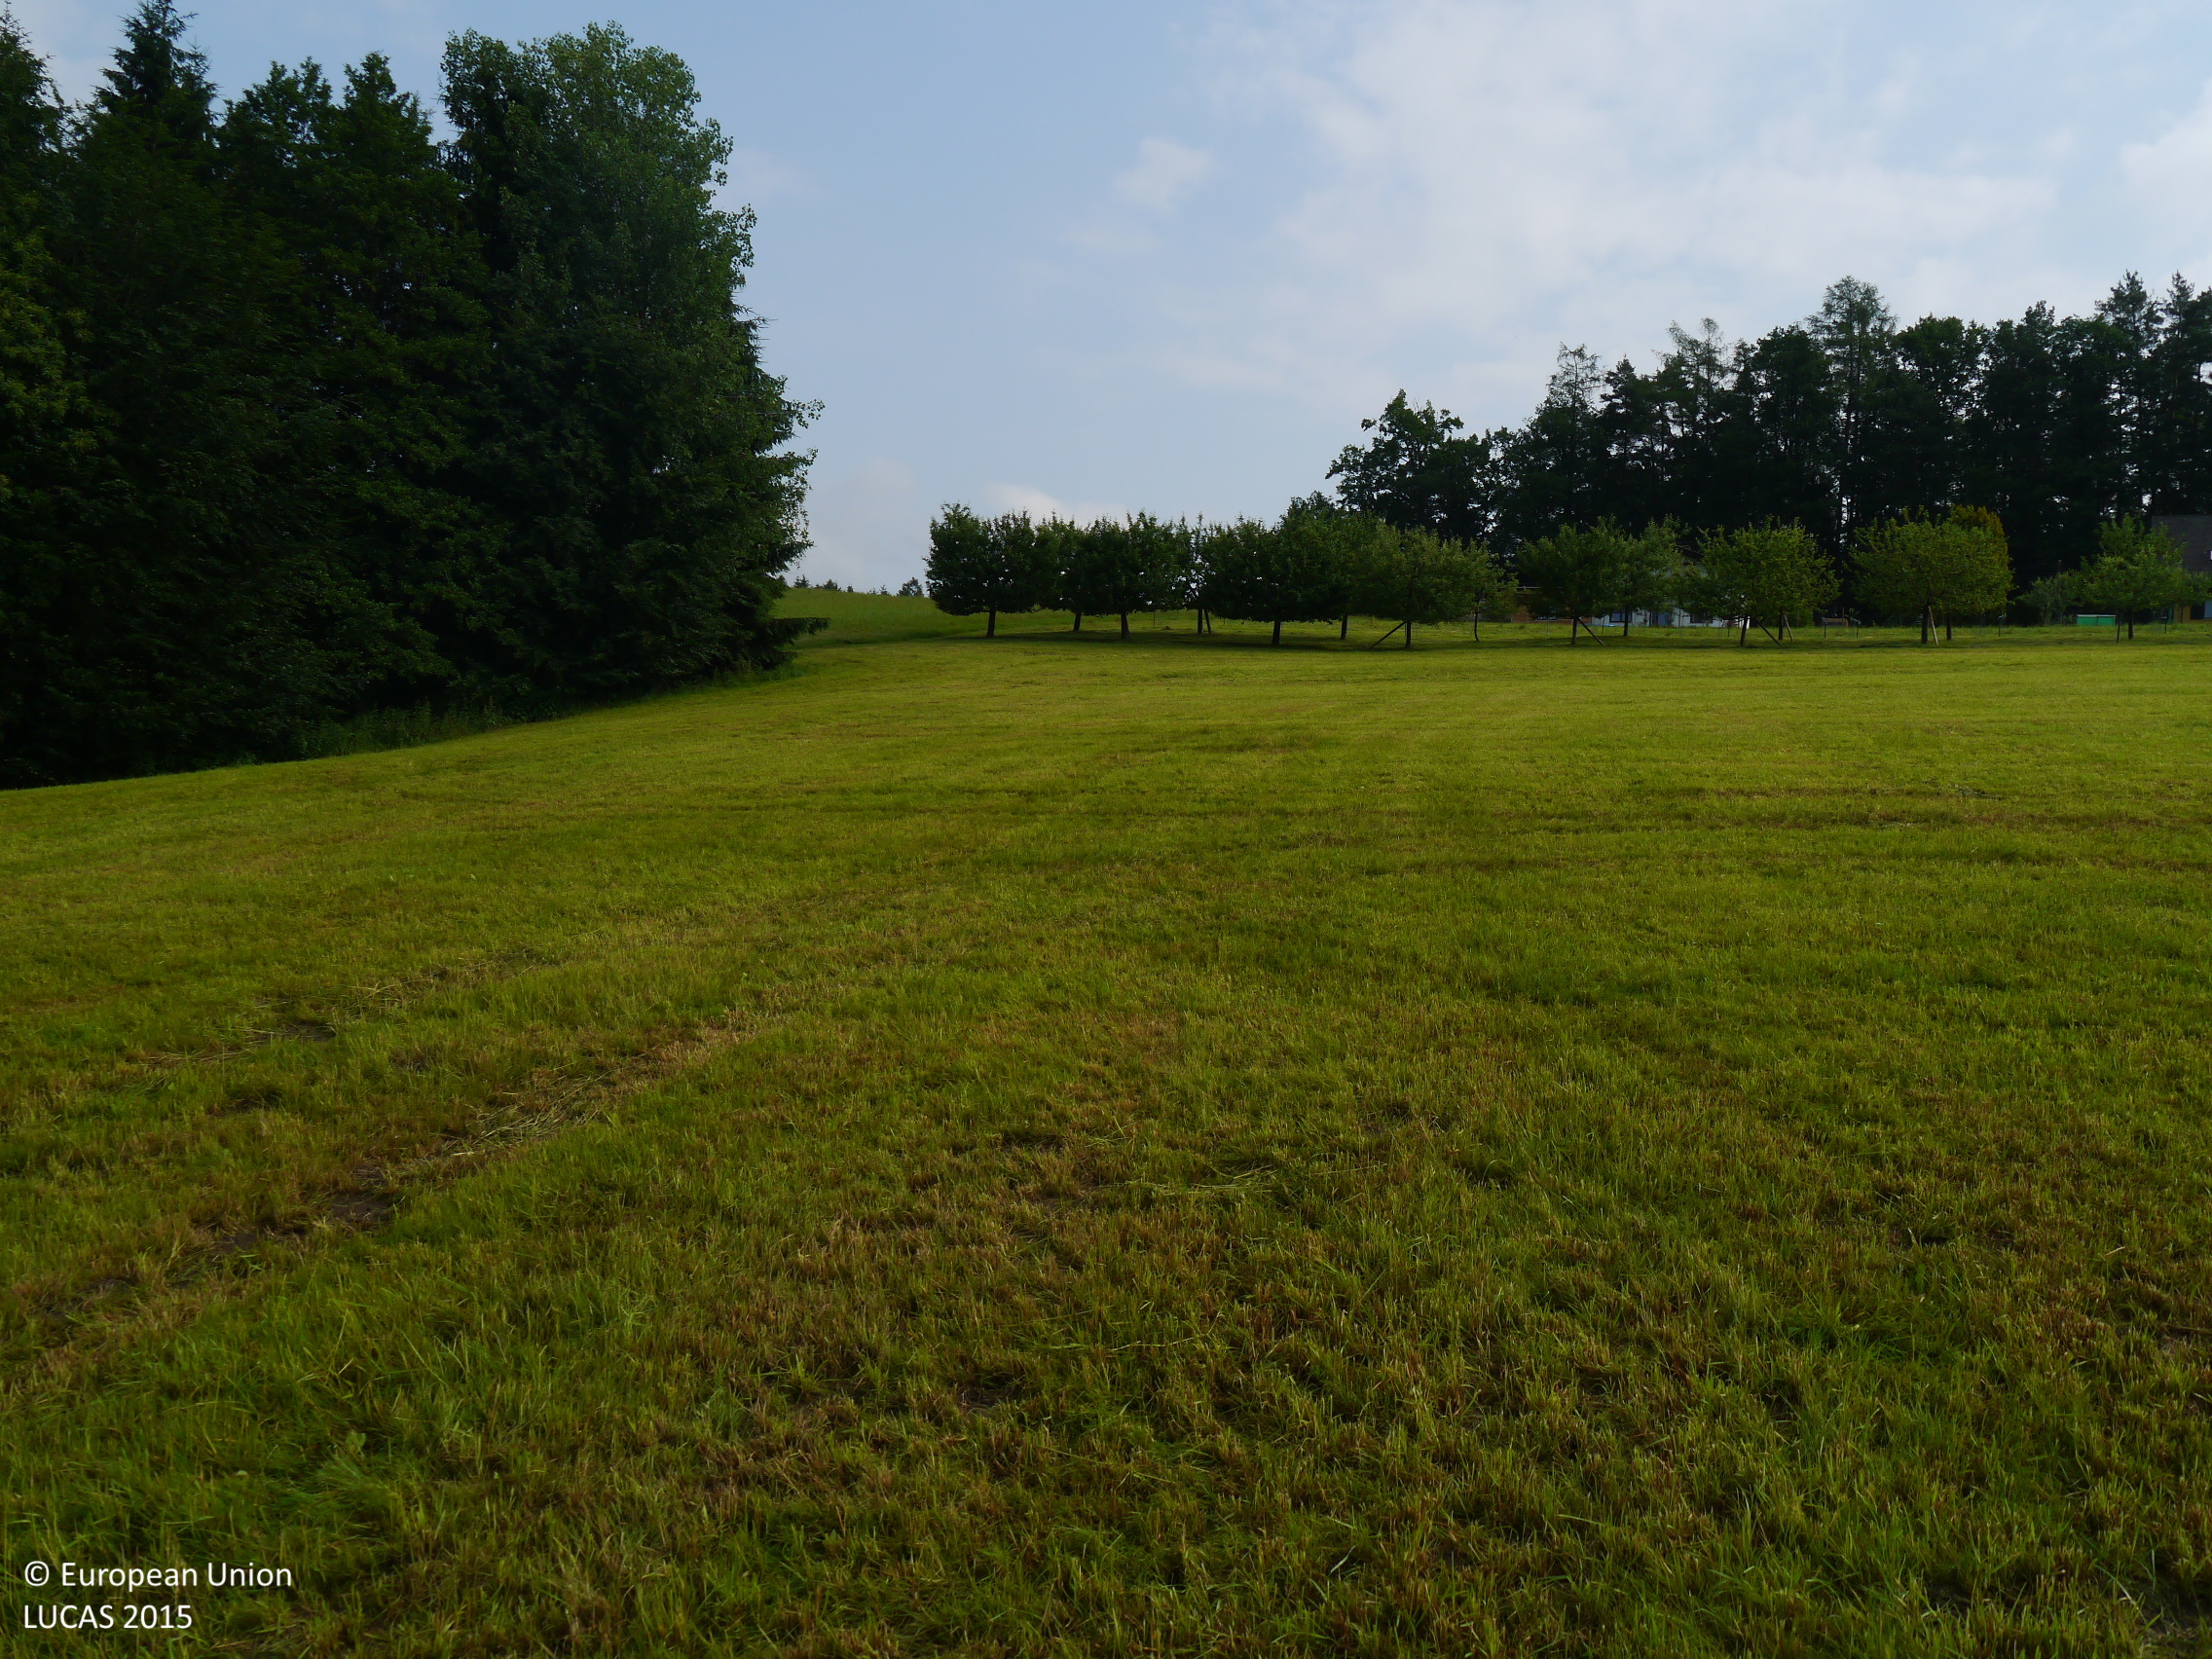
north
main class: Grassland
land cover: Grassland without tree/shrub cover
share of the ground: > 75 %
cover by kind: herbaceous plants 100 %
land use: Agriculture (excluding fallow land and kitchen gardens)
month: June
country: AT
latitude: 46.9266
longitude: 15.2393
